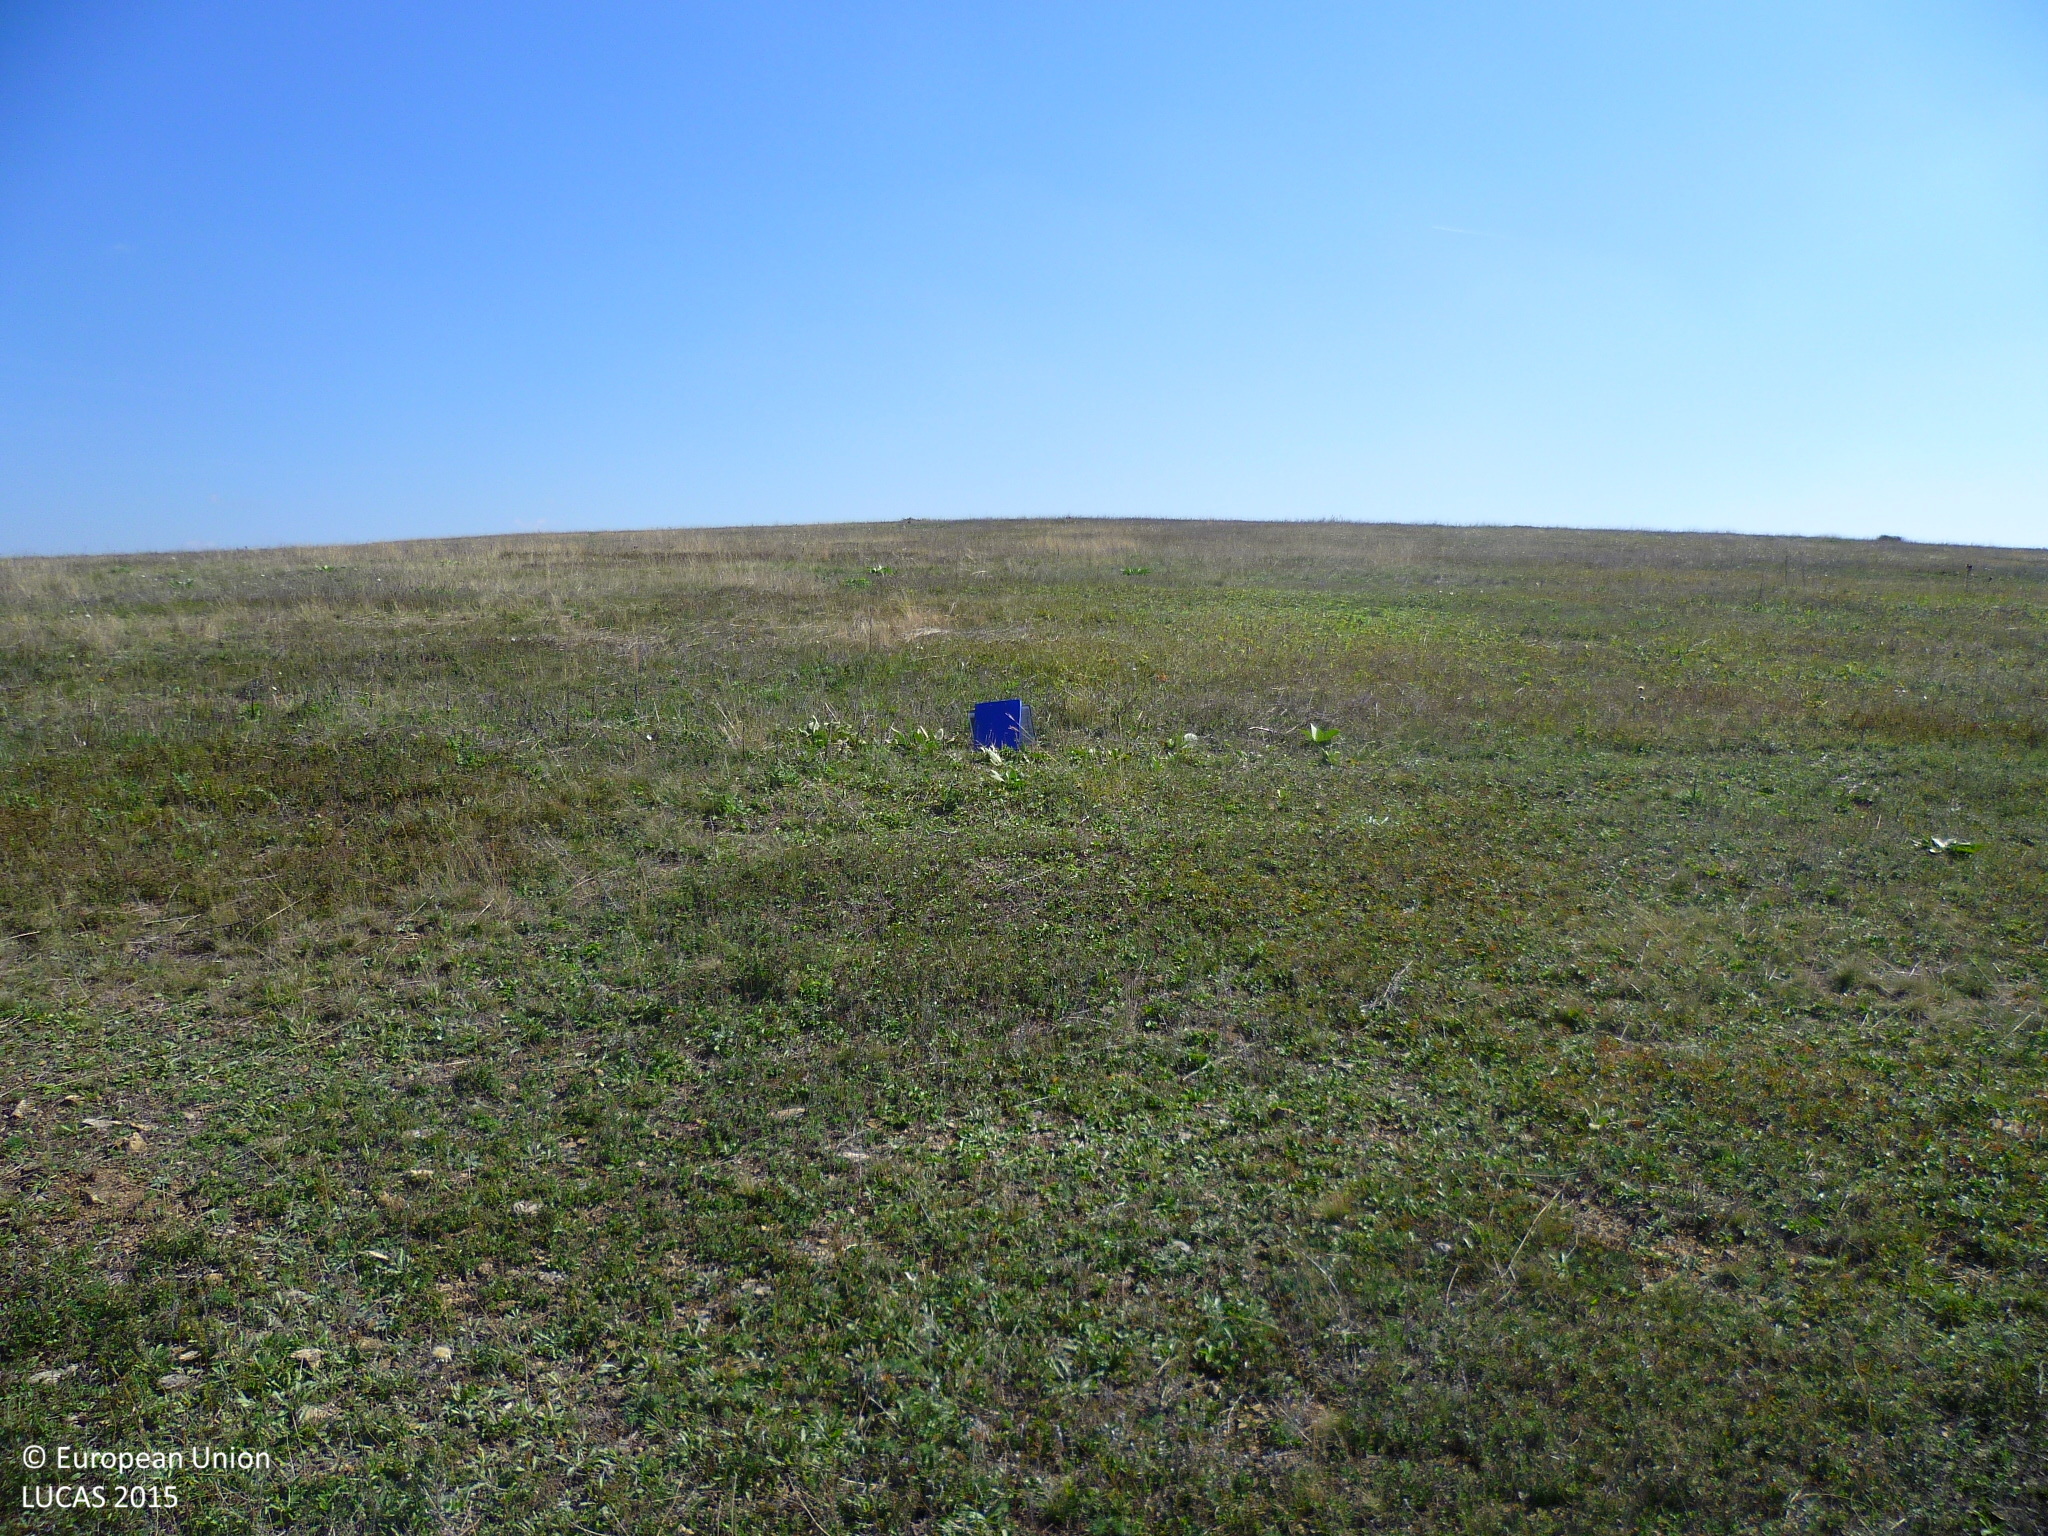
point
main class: Grassland
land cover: Grassland without tree/shrub cover
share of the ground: > 75 %
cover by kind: herbaceous plants 100 %
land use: Agriculture (excluding fallow land and kitchen gardens)
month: October
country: BG
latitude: 42.9402
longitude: 23.0349
